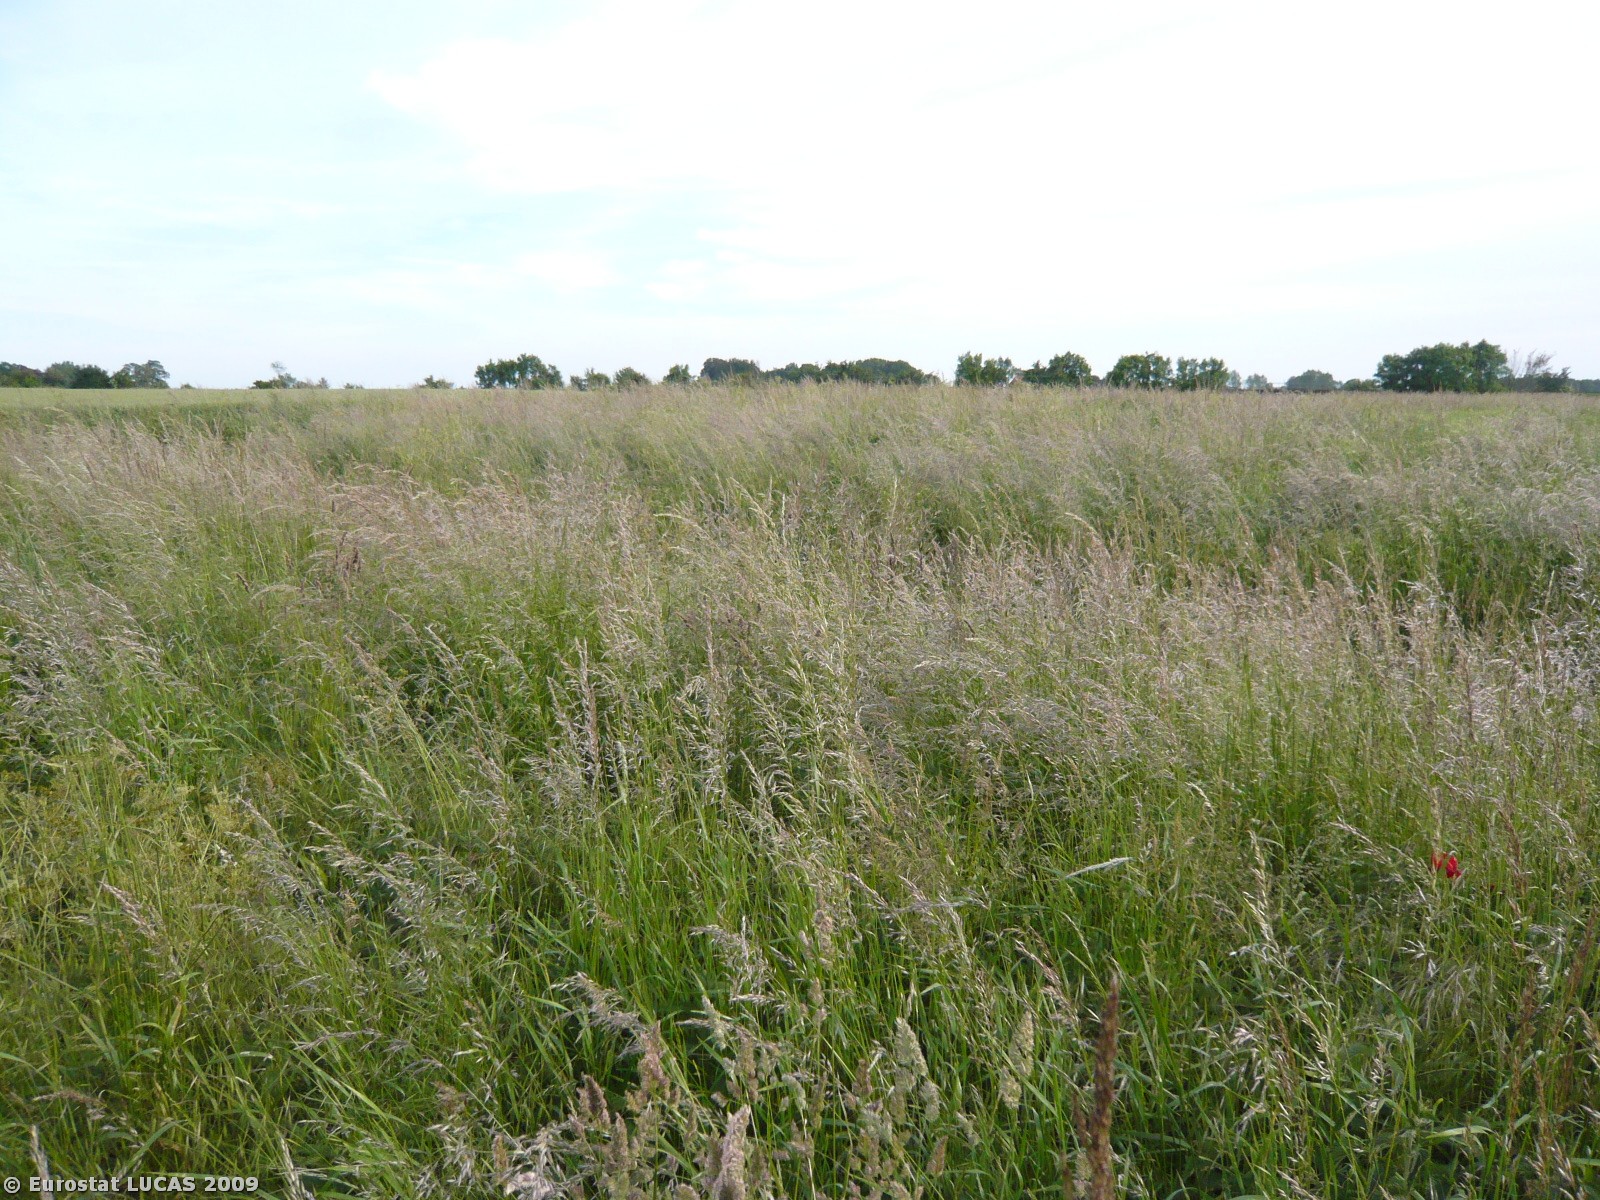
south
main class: Grassland
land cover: Grassland without tree/shrub cover
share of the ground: > 75 %
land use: Unused
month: June
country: DK
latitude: 54.8340
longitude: 11.1979
